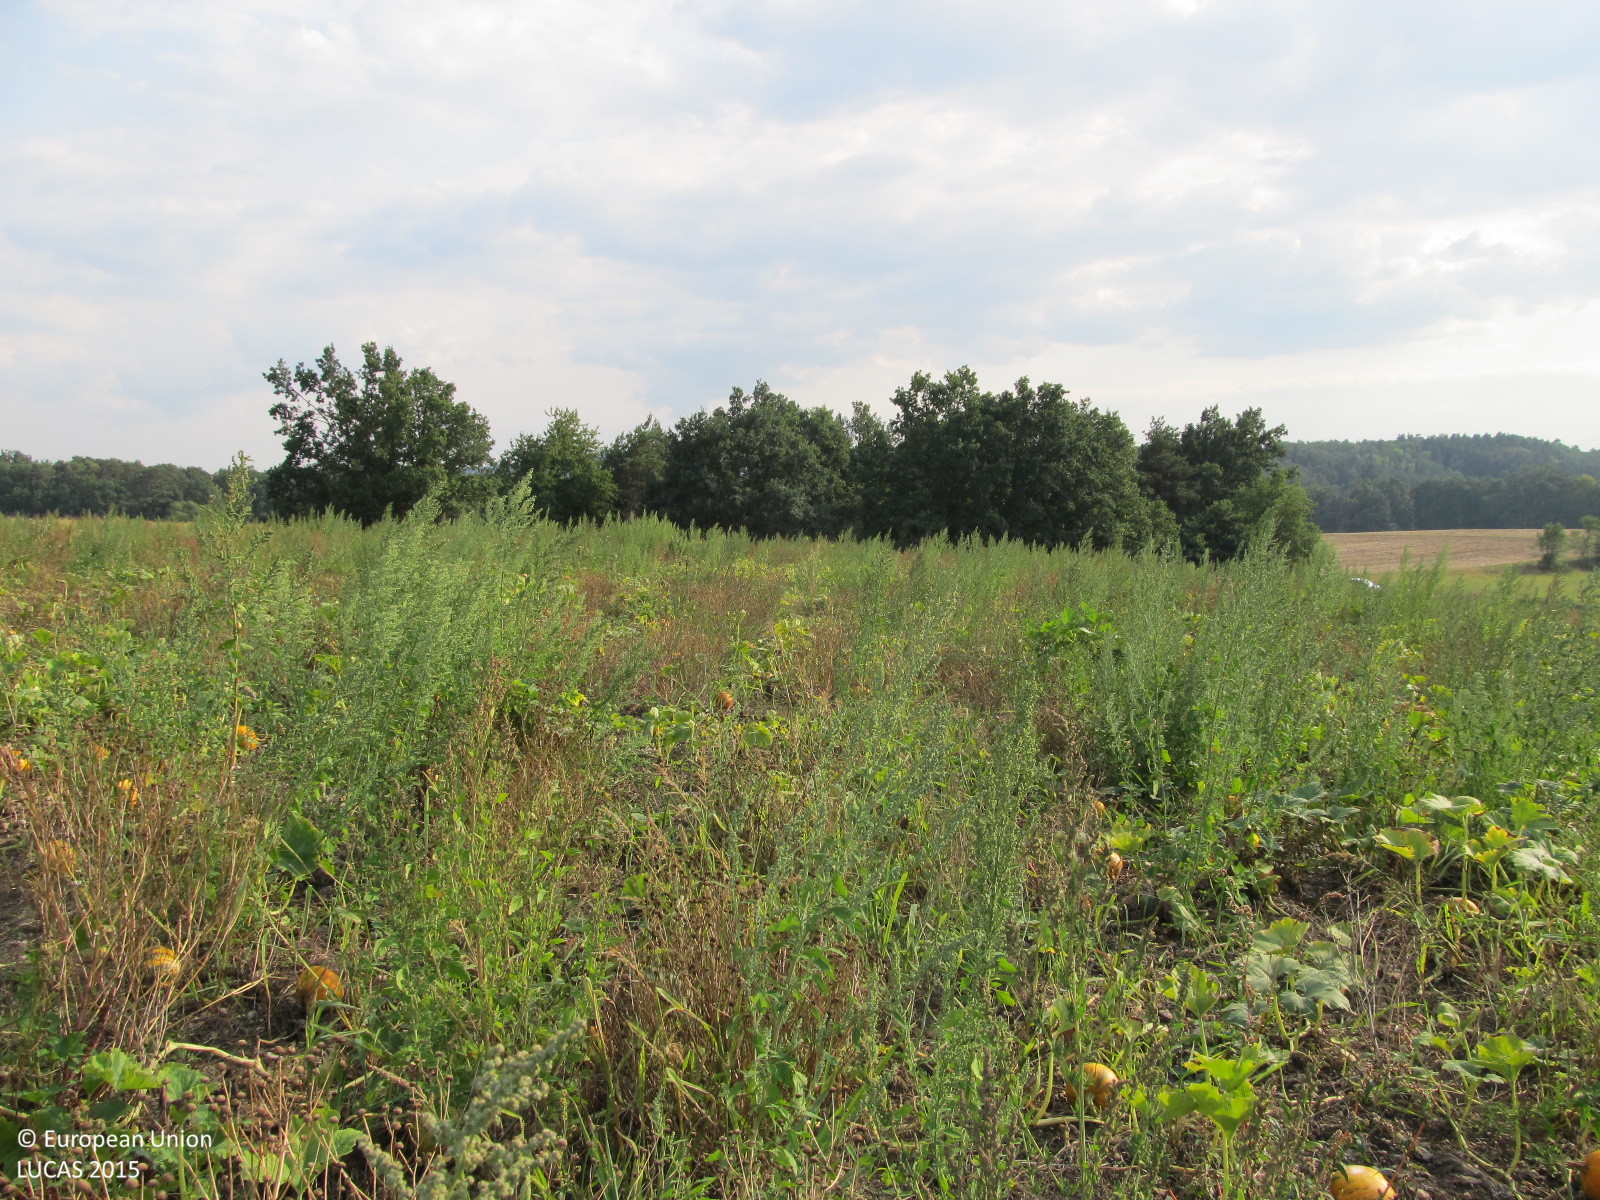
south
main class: Cropland
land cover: Other fibre and oleaginous crops
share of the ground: 50 - 75 %
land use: Agriculture (excluding fallow land and kitchen gardens)
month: August
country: AT
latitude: 48.6799
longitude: 15.5309
